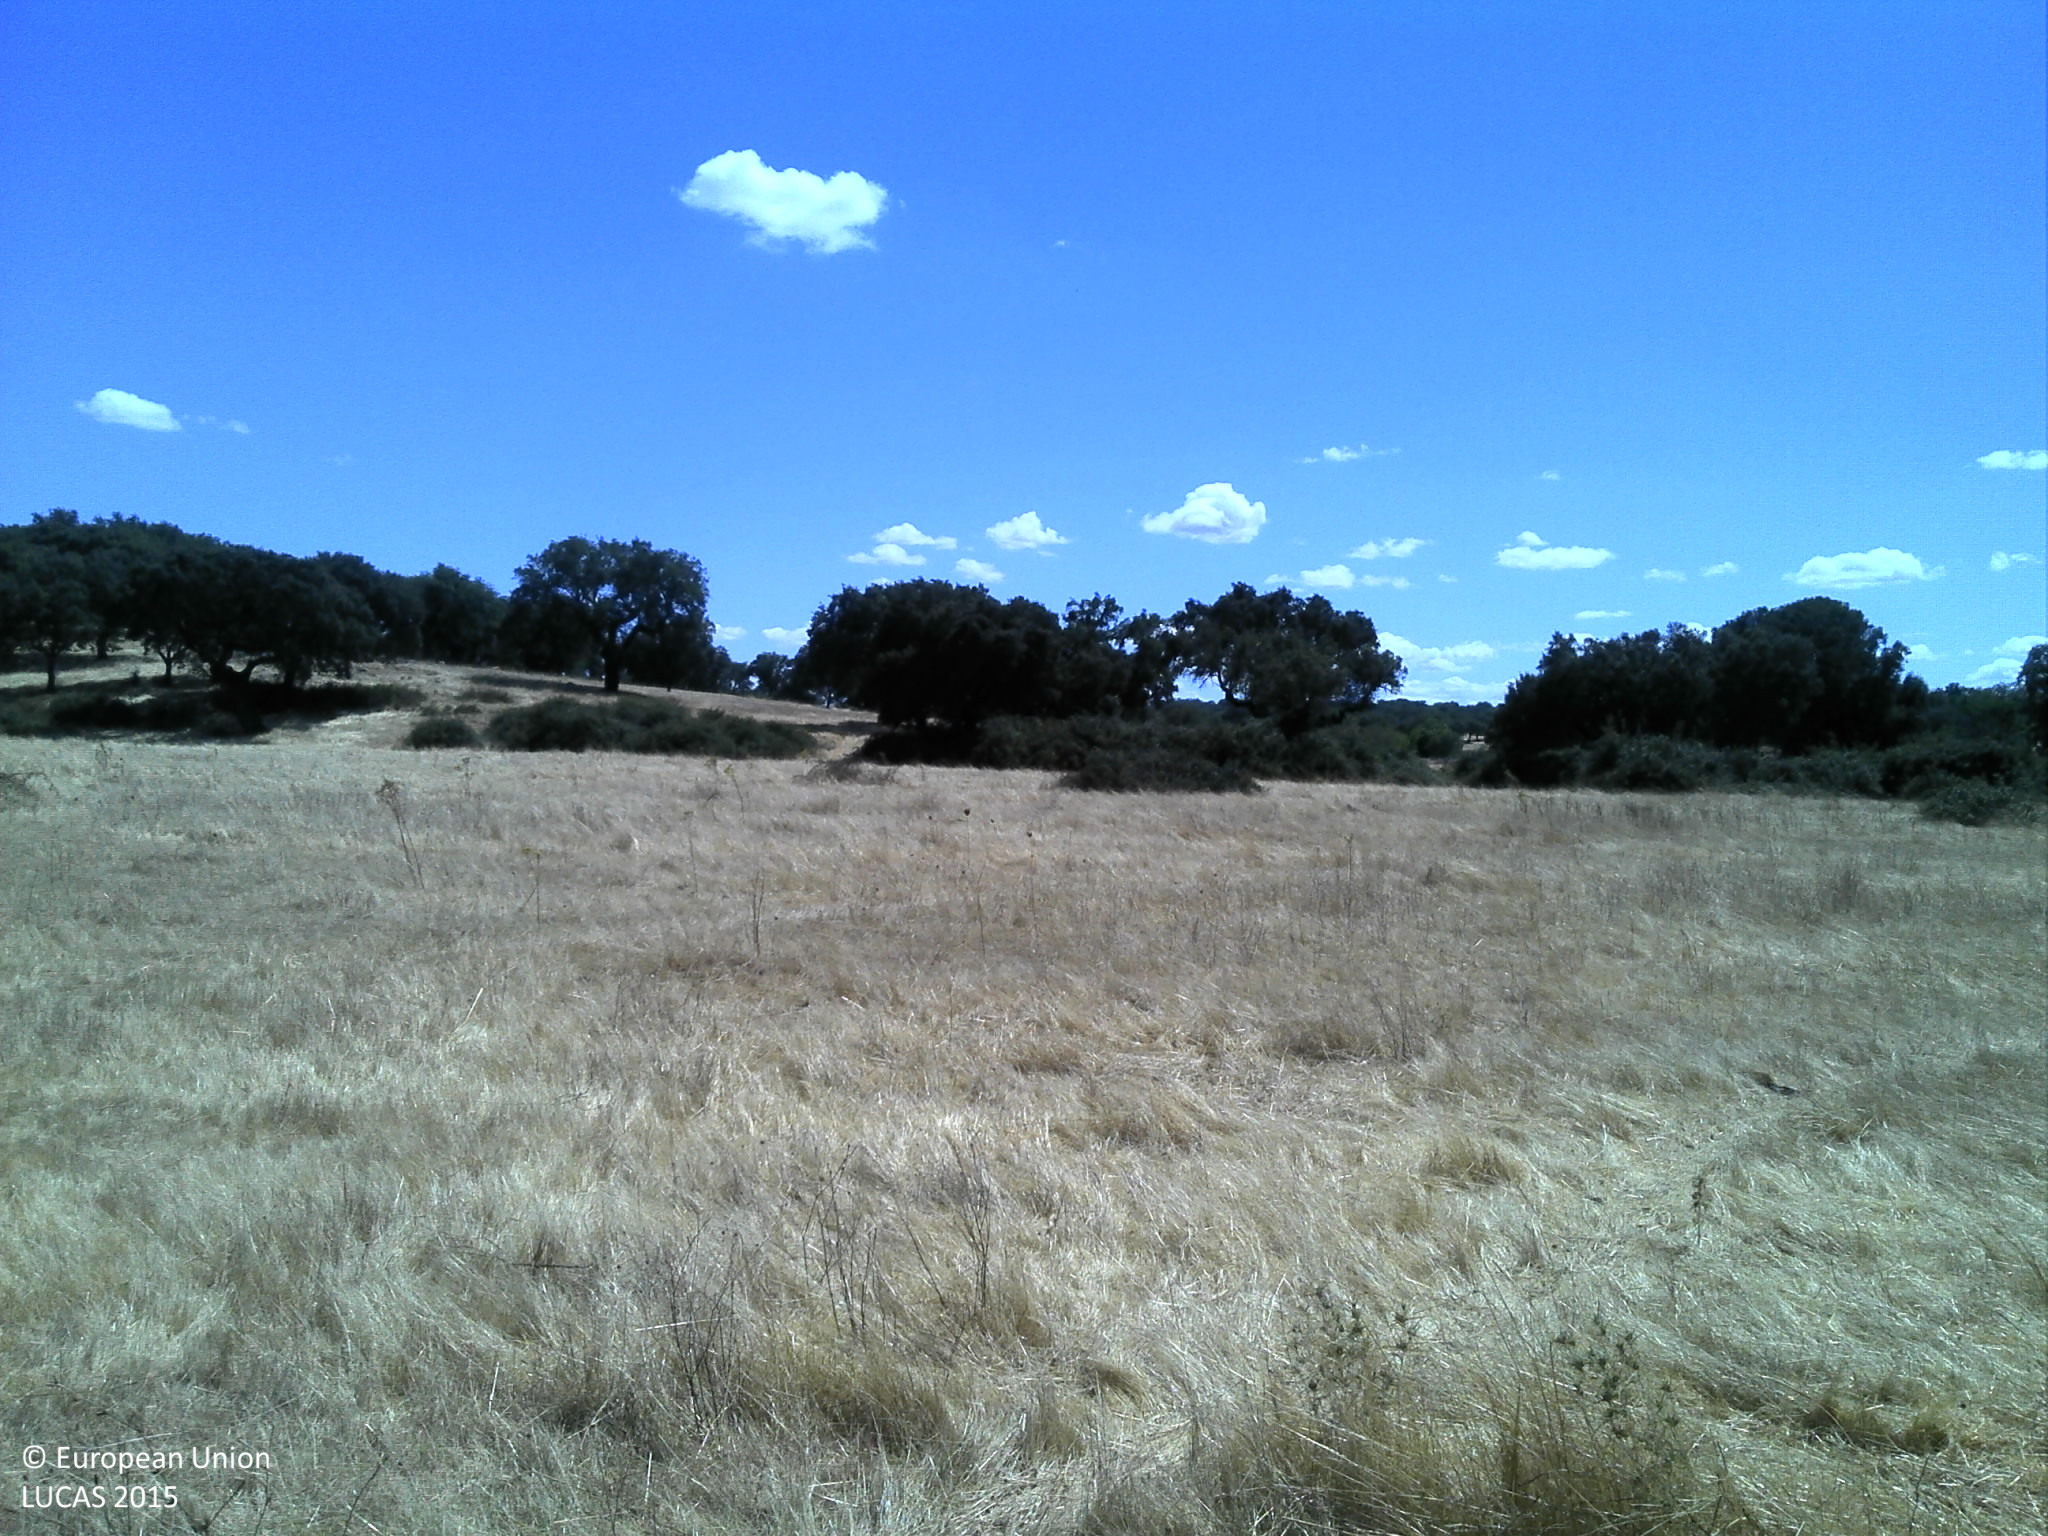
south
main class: Grassland
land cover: Grassland without tree/shrub cover
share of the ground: 50 - 75 %
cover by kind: herbaceous plants 60 %, unconsolidated bare surface 40 %
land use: Agriculture (excluding fallow land and kitchen gardens)
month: July
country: PT
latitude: 39.1899
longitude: -7.4411
